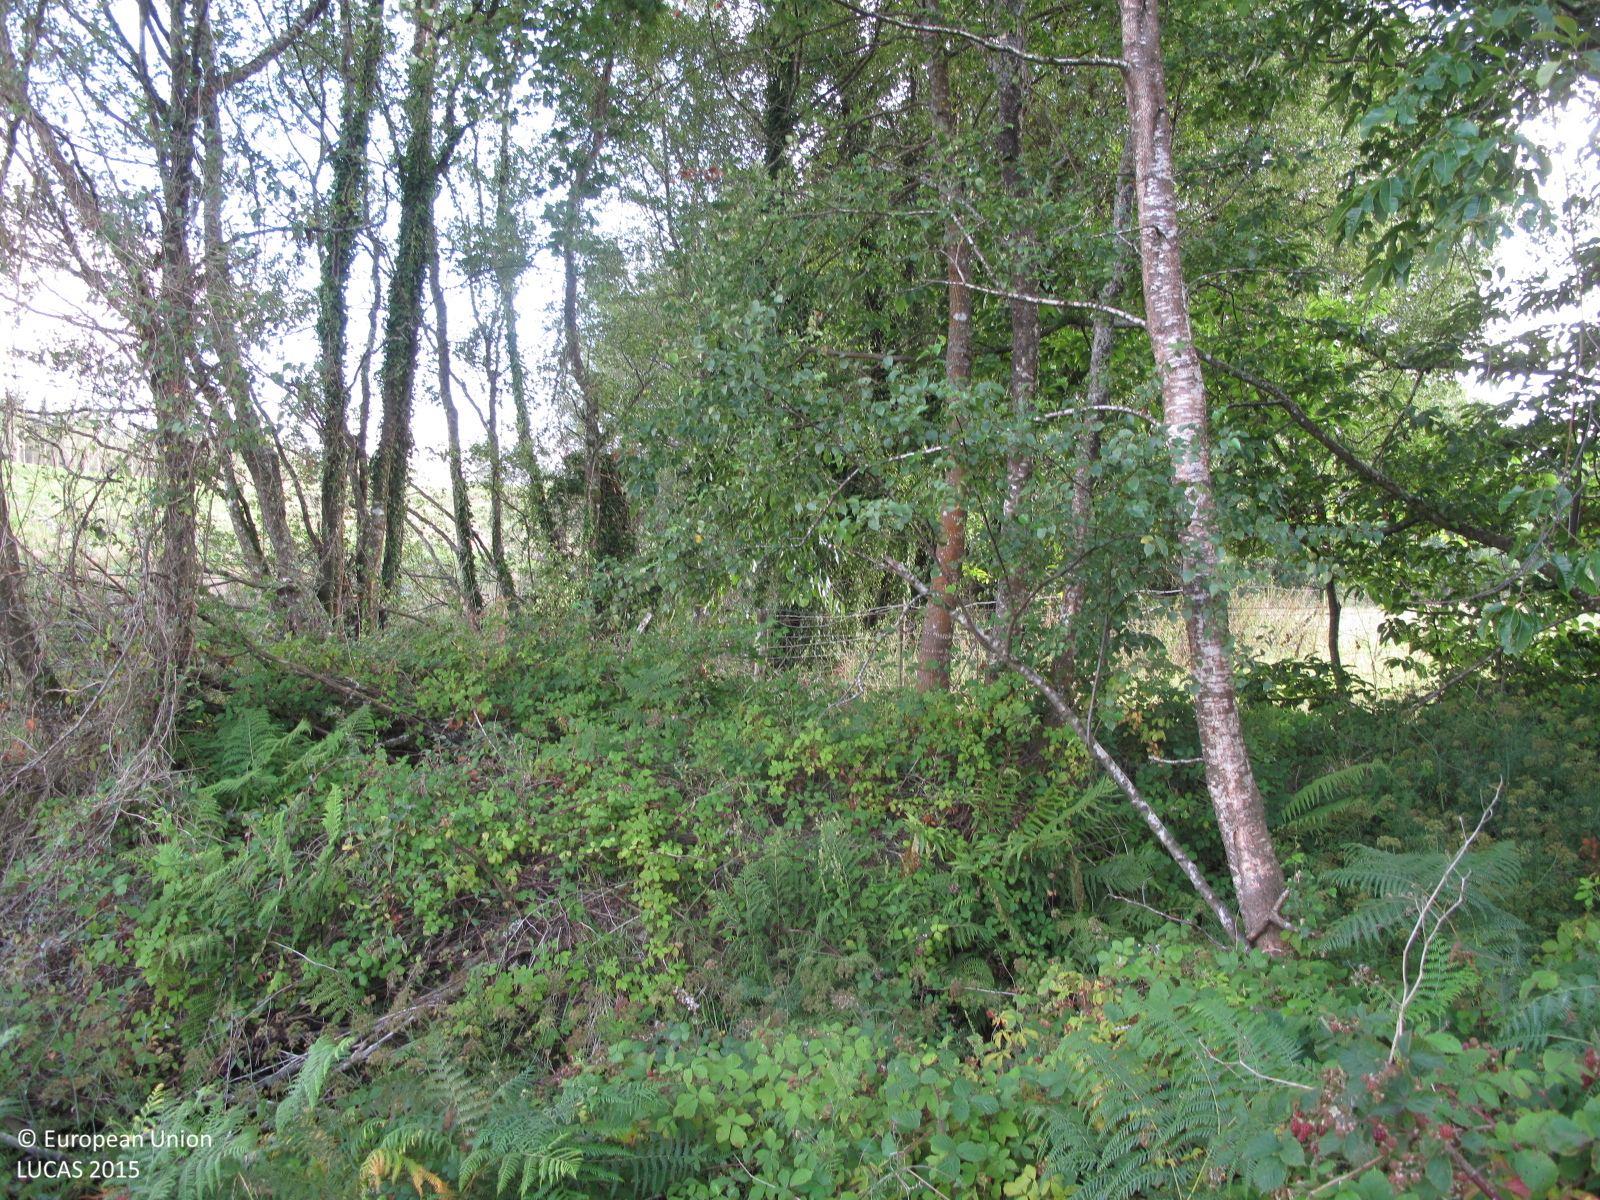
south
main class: Woodland
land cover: Broadleaved woodland
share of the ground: > 75 %
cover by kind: broadleaved forest trees 90 %, shrubs 10 %
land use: Semi-natural and natural areas not in use
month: July
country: ES
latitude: 43.1159
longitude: -7.9722
